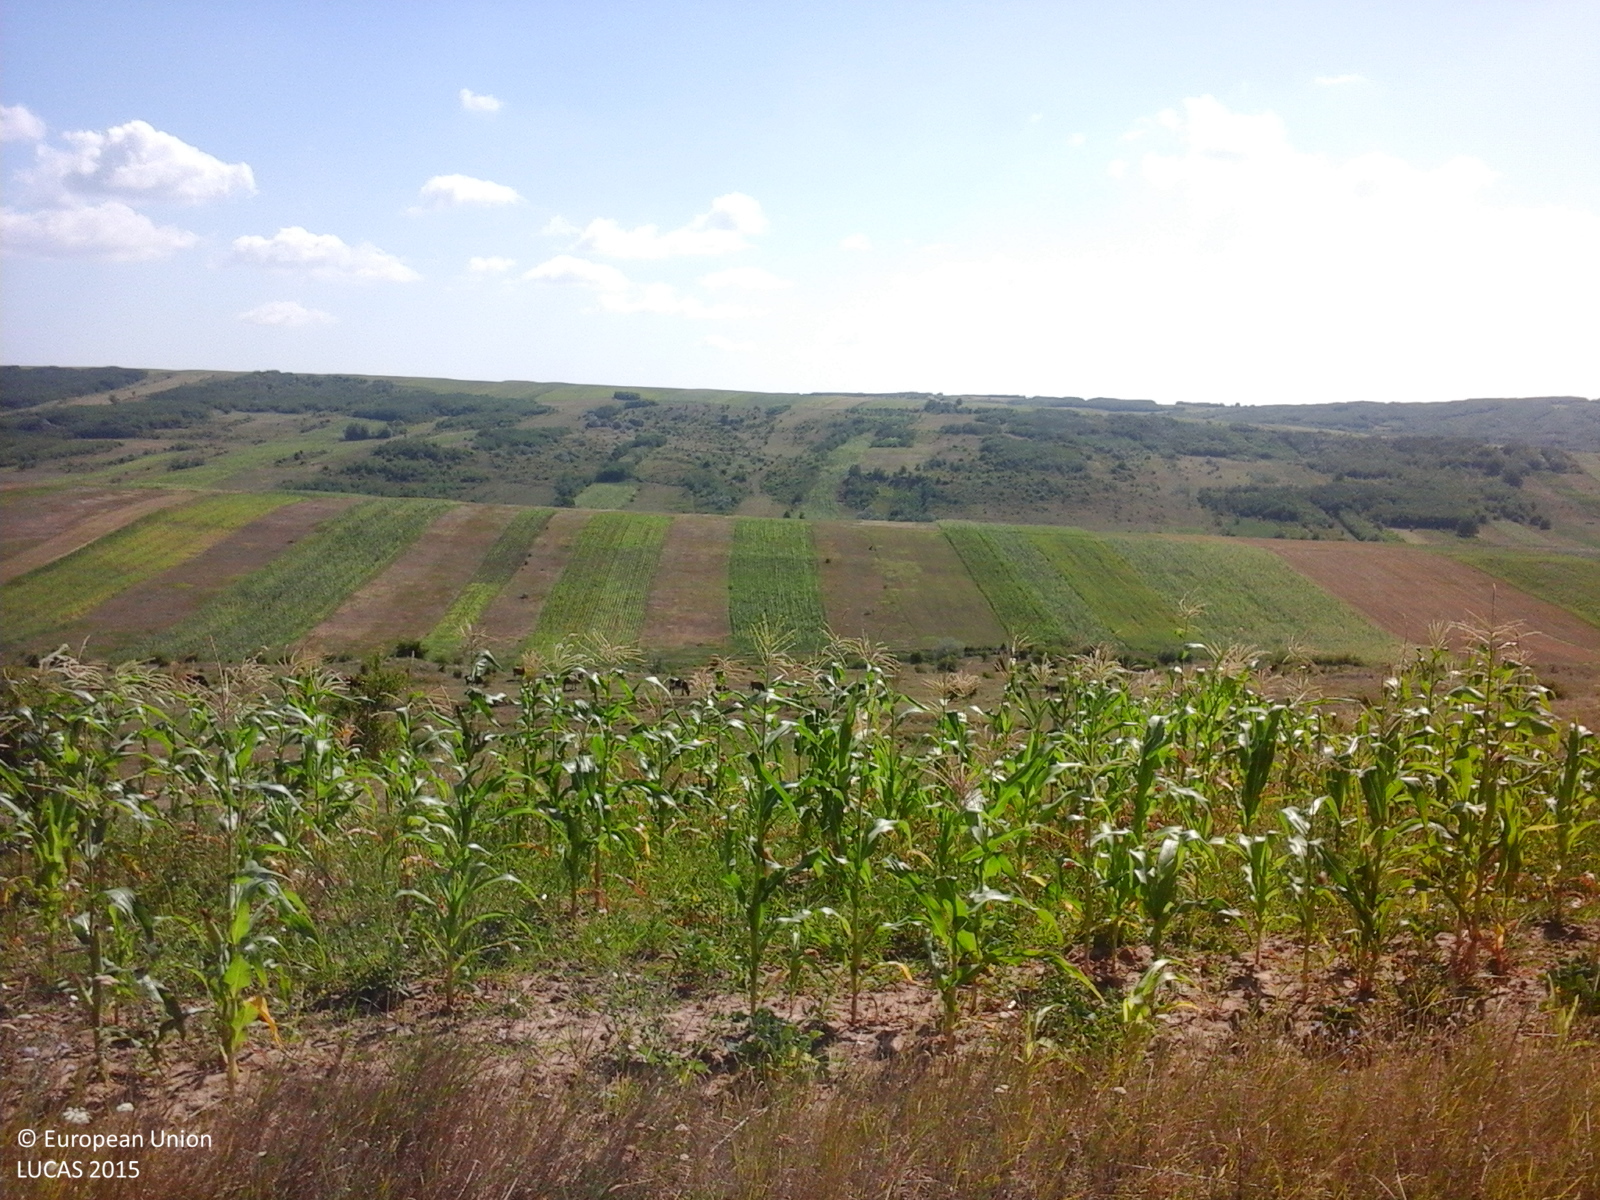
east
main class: Grassland
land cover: Grassland without tree/shrub cover
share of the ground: > 75 %
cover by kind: herbaceous plants 100 %
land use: Agriculture (excluding fallow land and kitchen gardens)
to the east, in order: Grassland without tree/shrub cover; Maize; Grass margins; Tracks; Grassland without tree/shrub cover; Grassland with sparse tree/shrub cover
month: July
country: RO
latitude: 46.1613
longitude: 27.8474
